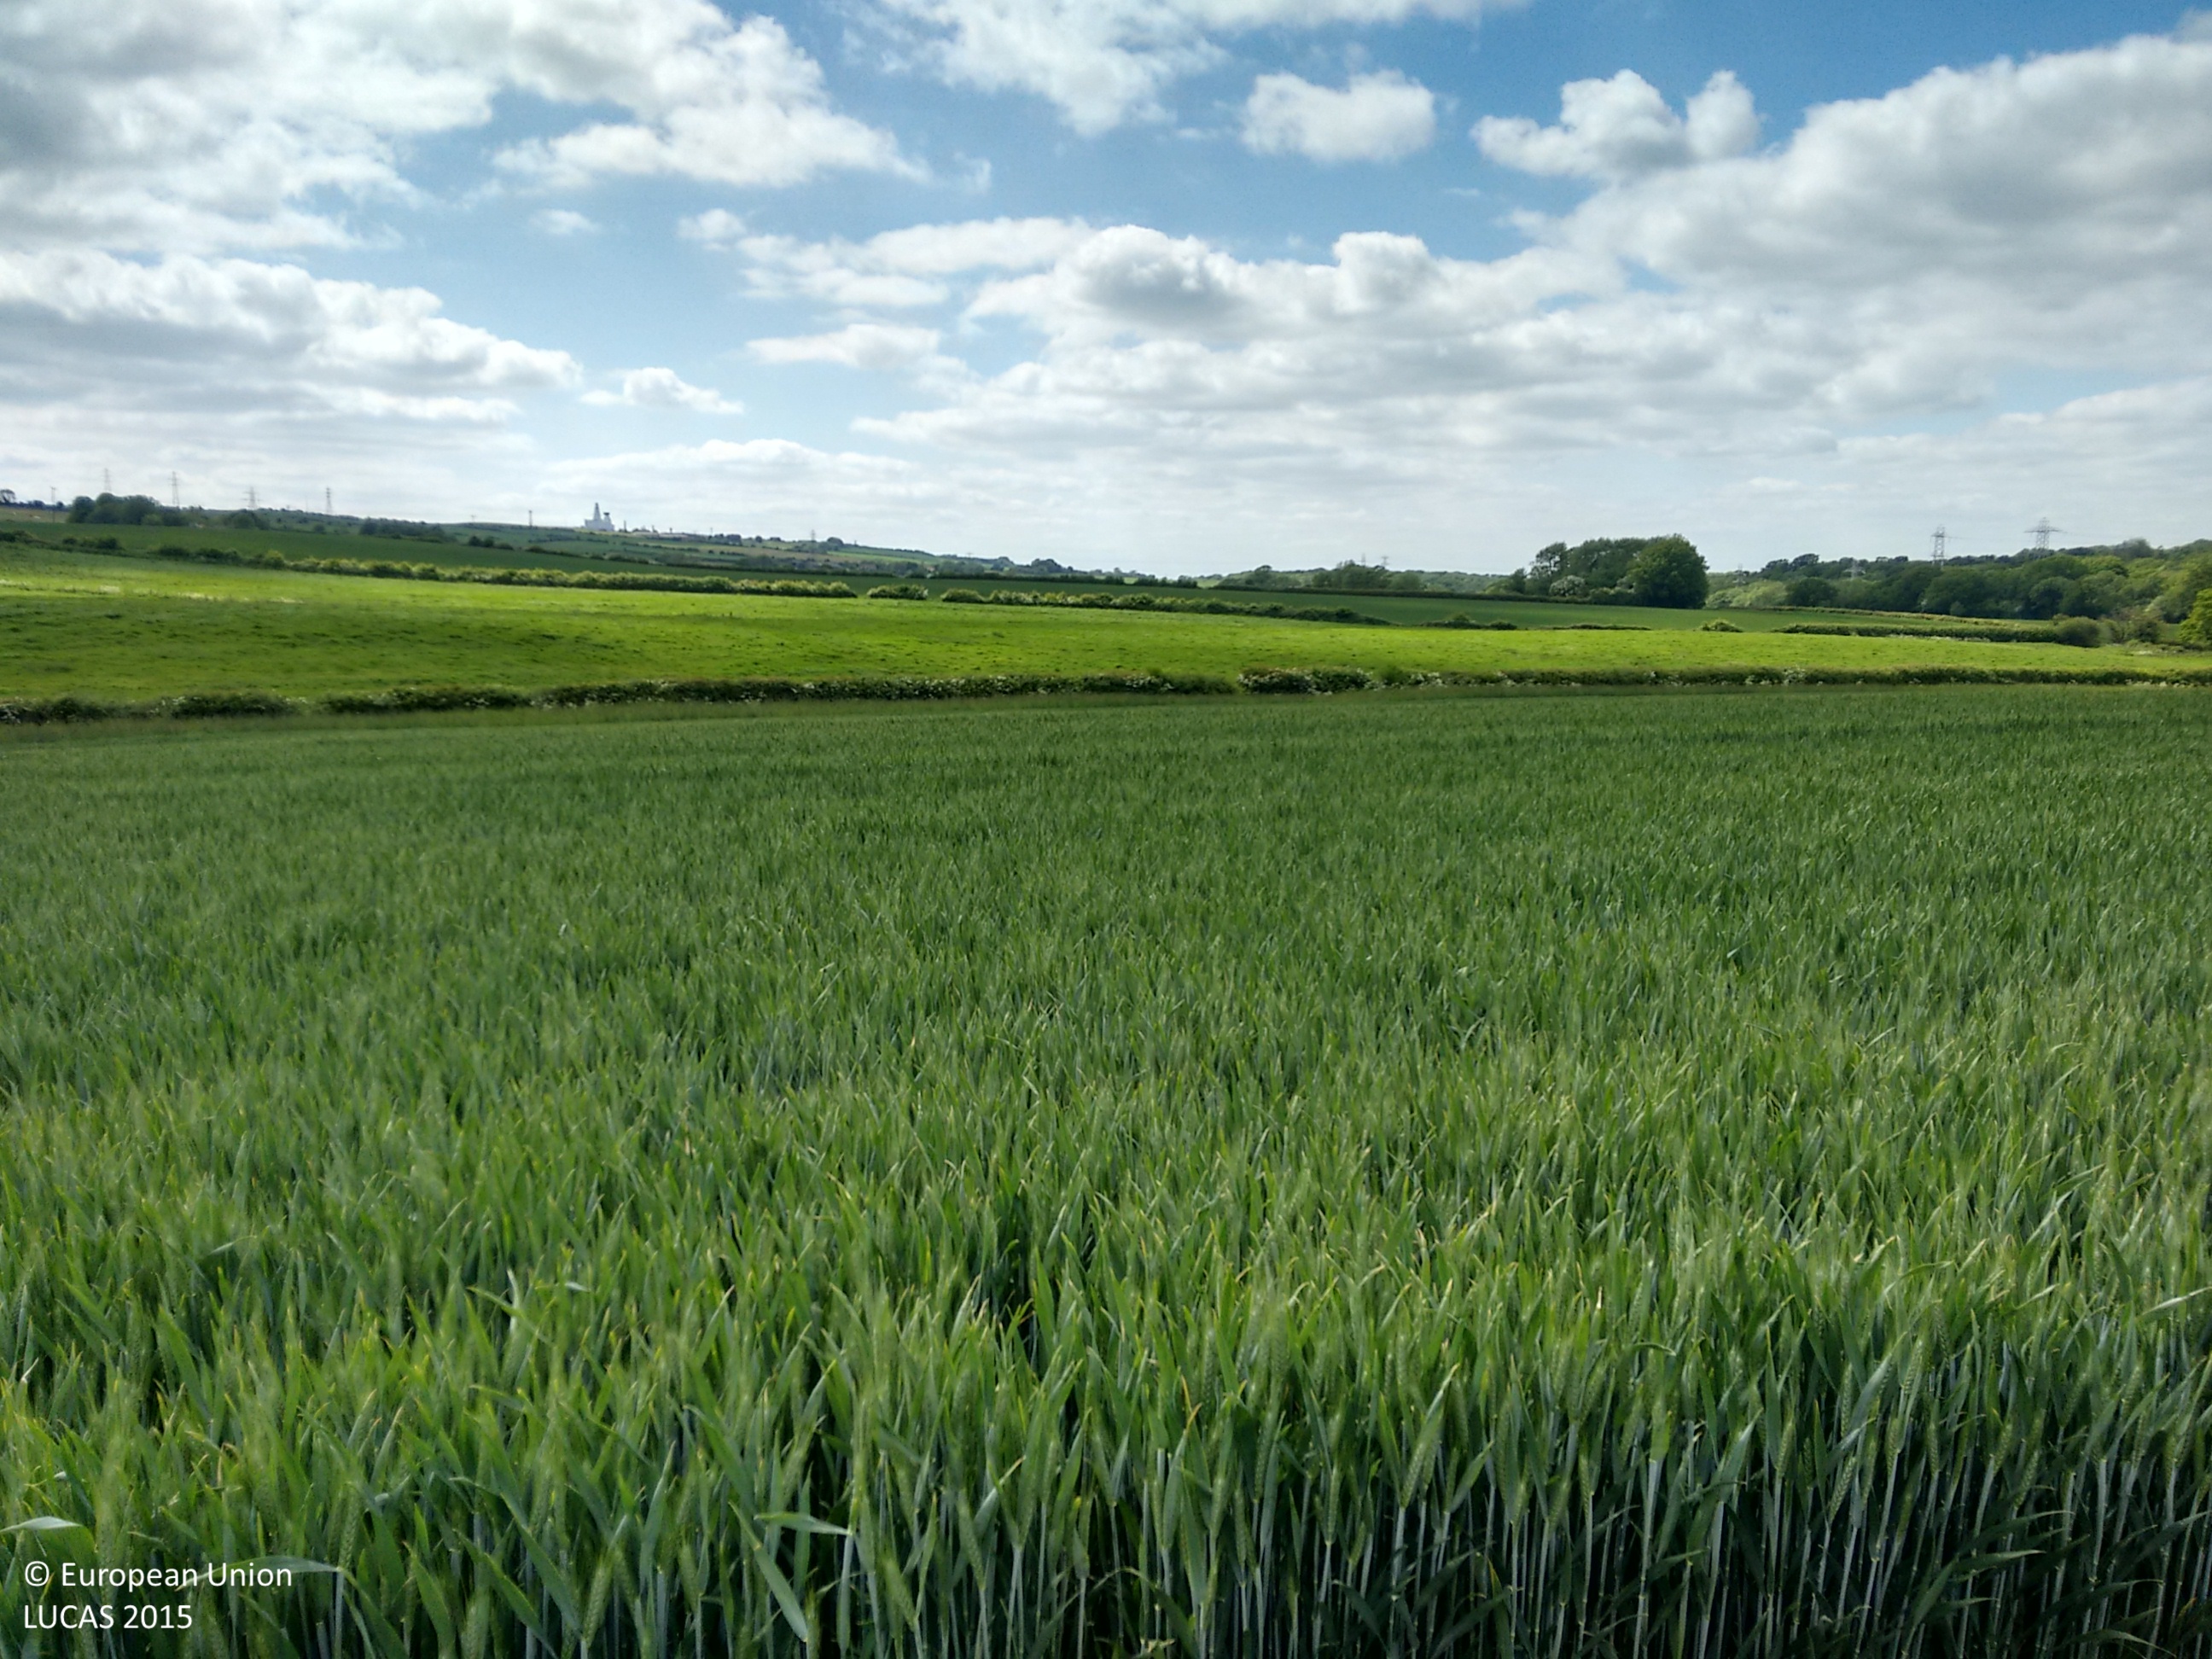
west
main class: Cropland
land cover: Common wheat
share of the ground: > 75 %
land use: Agriculture (excluding fallow land and kitchen gardens)
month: May
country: GB
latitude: 50.8610
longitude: -1.0556
